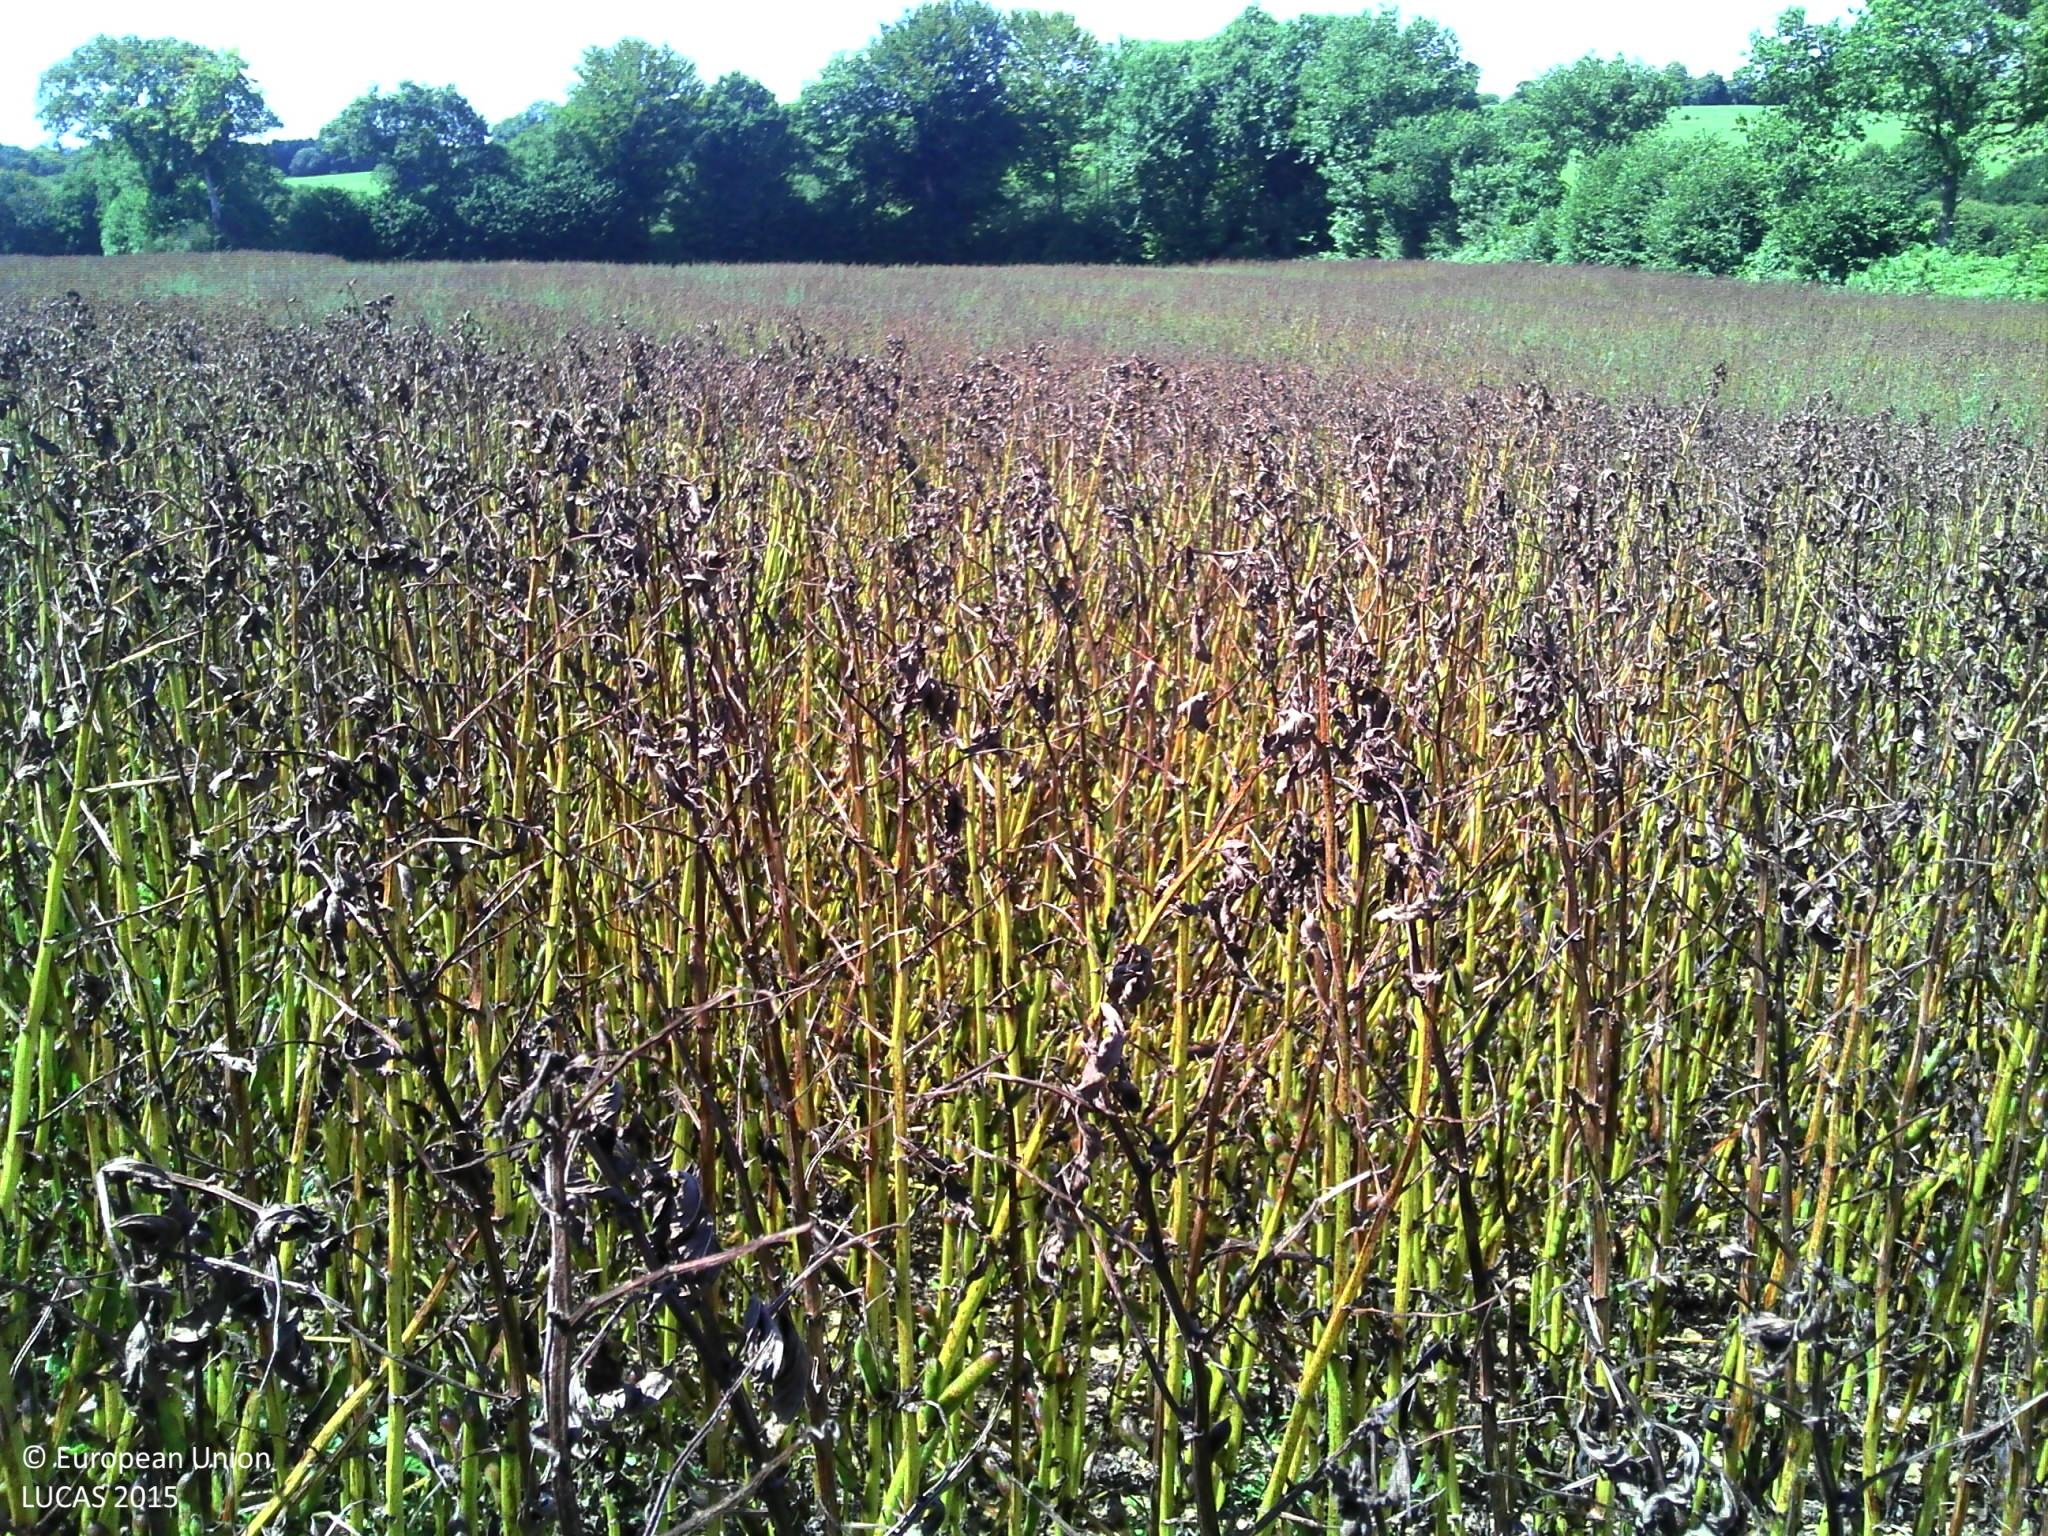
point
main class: Cropland
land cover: Dry pulses
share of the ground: > 75 %
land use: Agriculture (excluding fallow land and kitchen gardens)
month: August
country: FR
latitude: 48.4525
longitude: -3.4502
